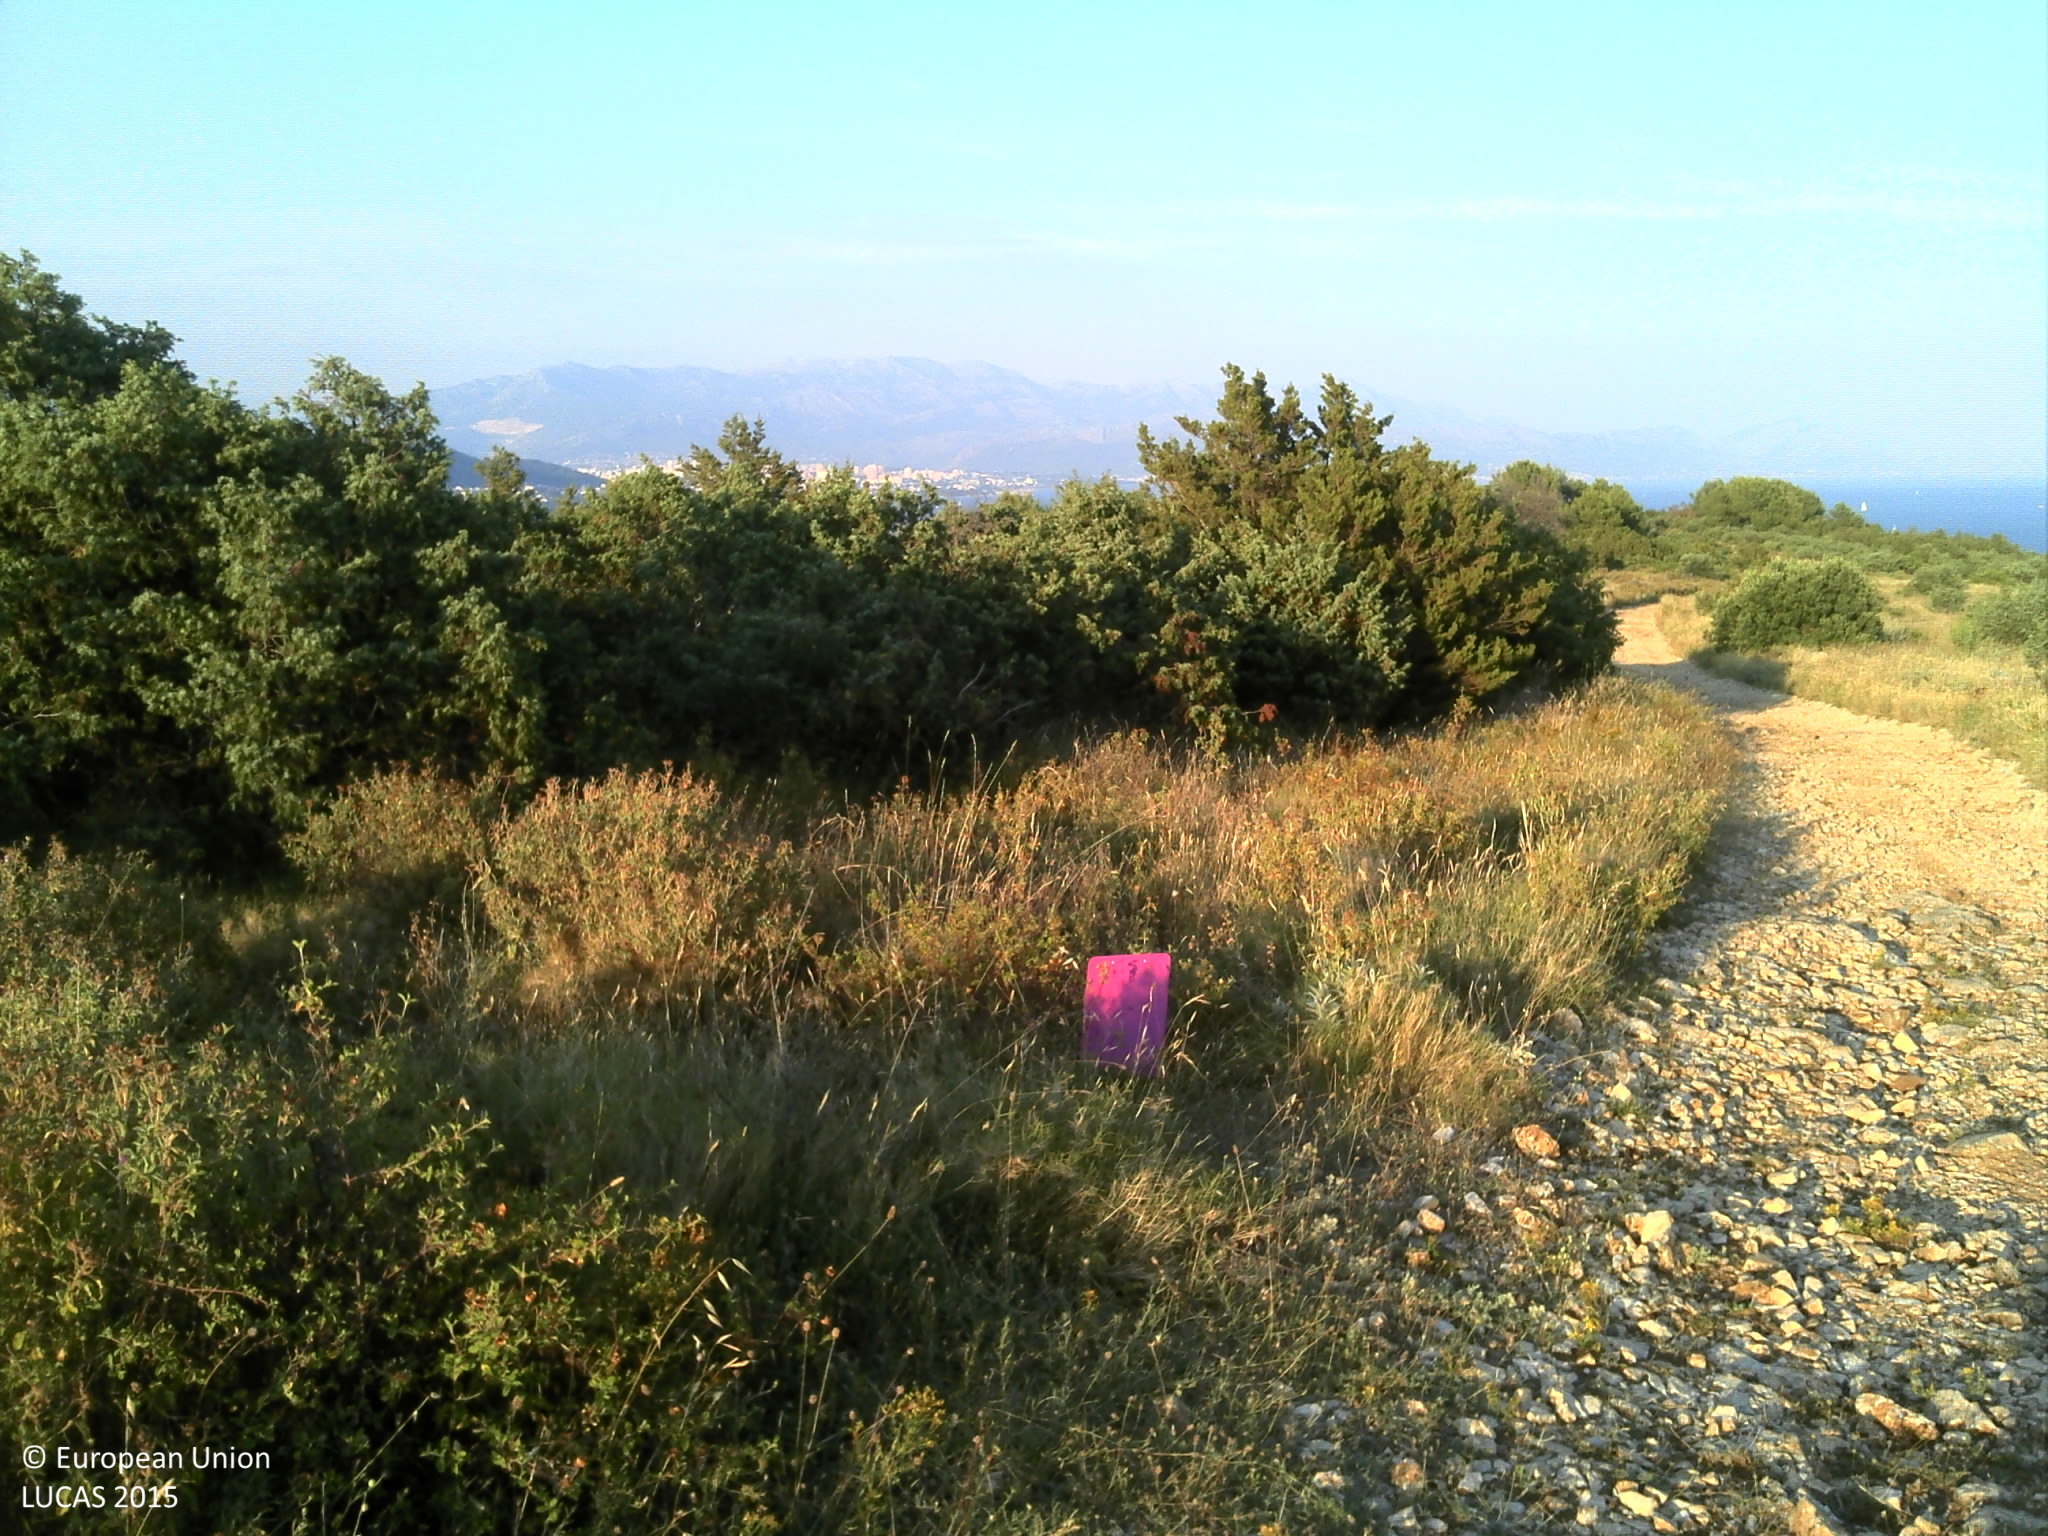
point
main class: Shrubland
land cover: Shrubland without tree cover
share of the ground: 50 - 75 %
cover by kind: shrubs 70 %, herbaceous plants 20 %, consolidated bare surface 5 %, unconsolidated bare surface 5 %
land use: Semi-natural and natural areas not in use
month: July
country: HR
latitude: 43.4861
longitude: 16.3584
